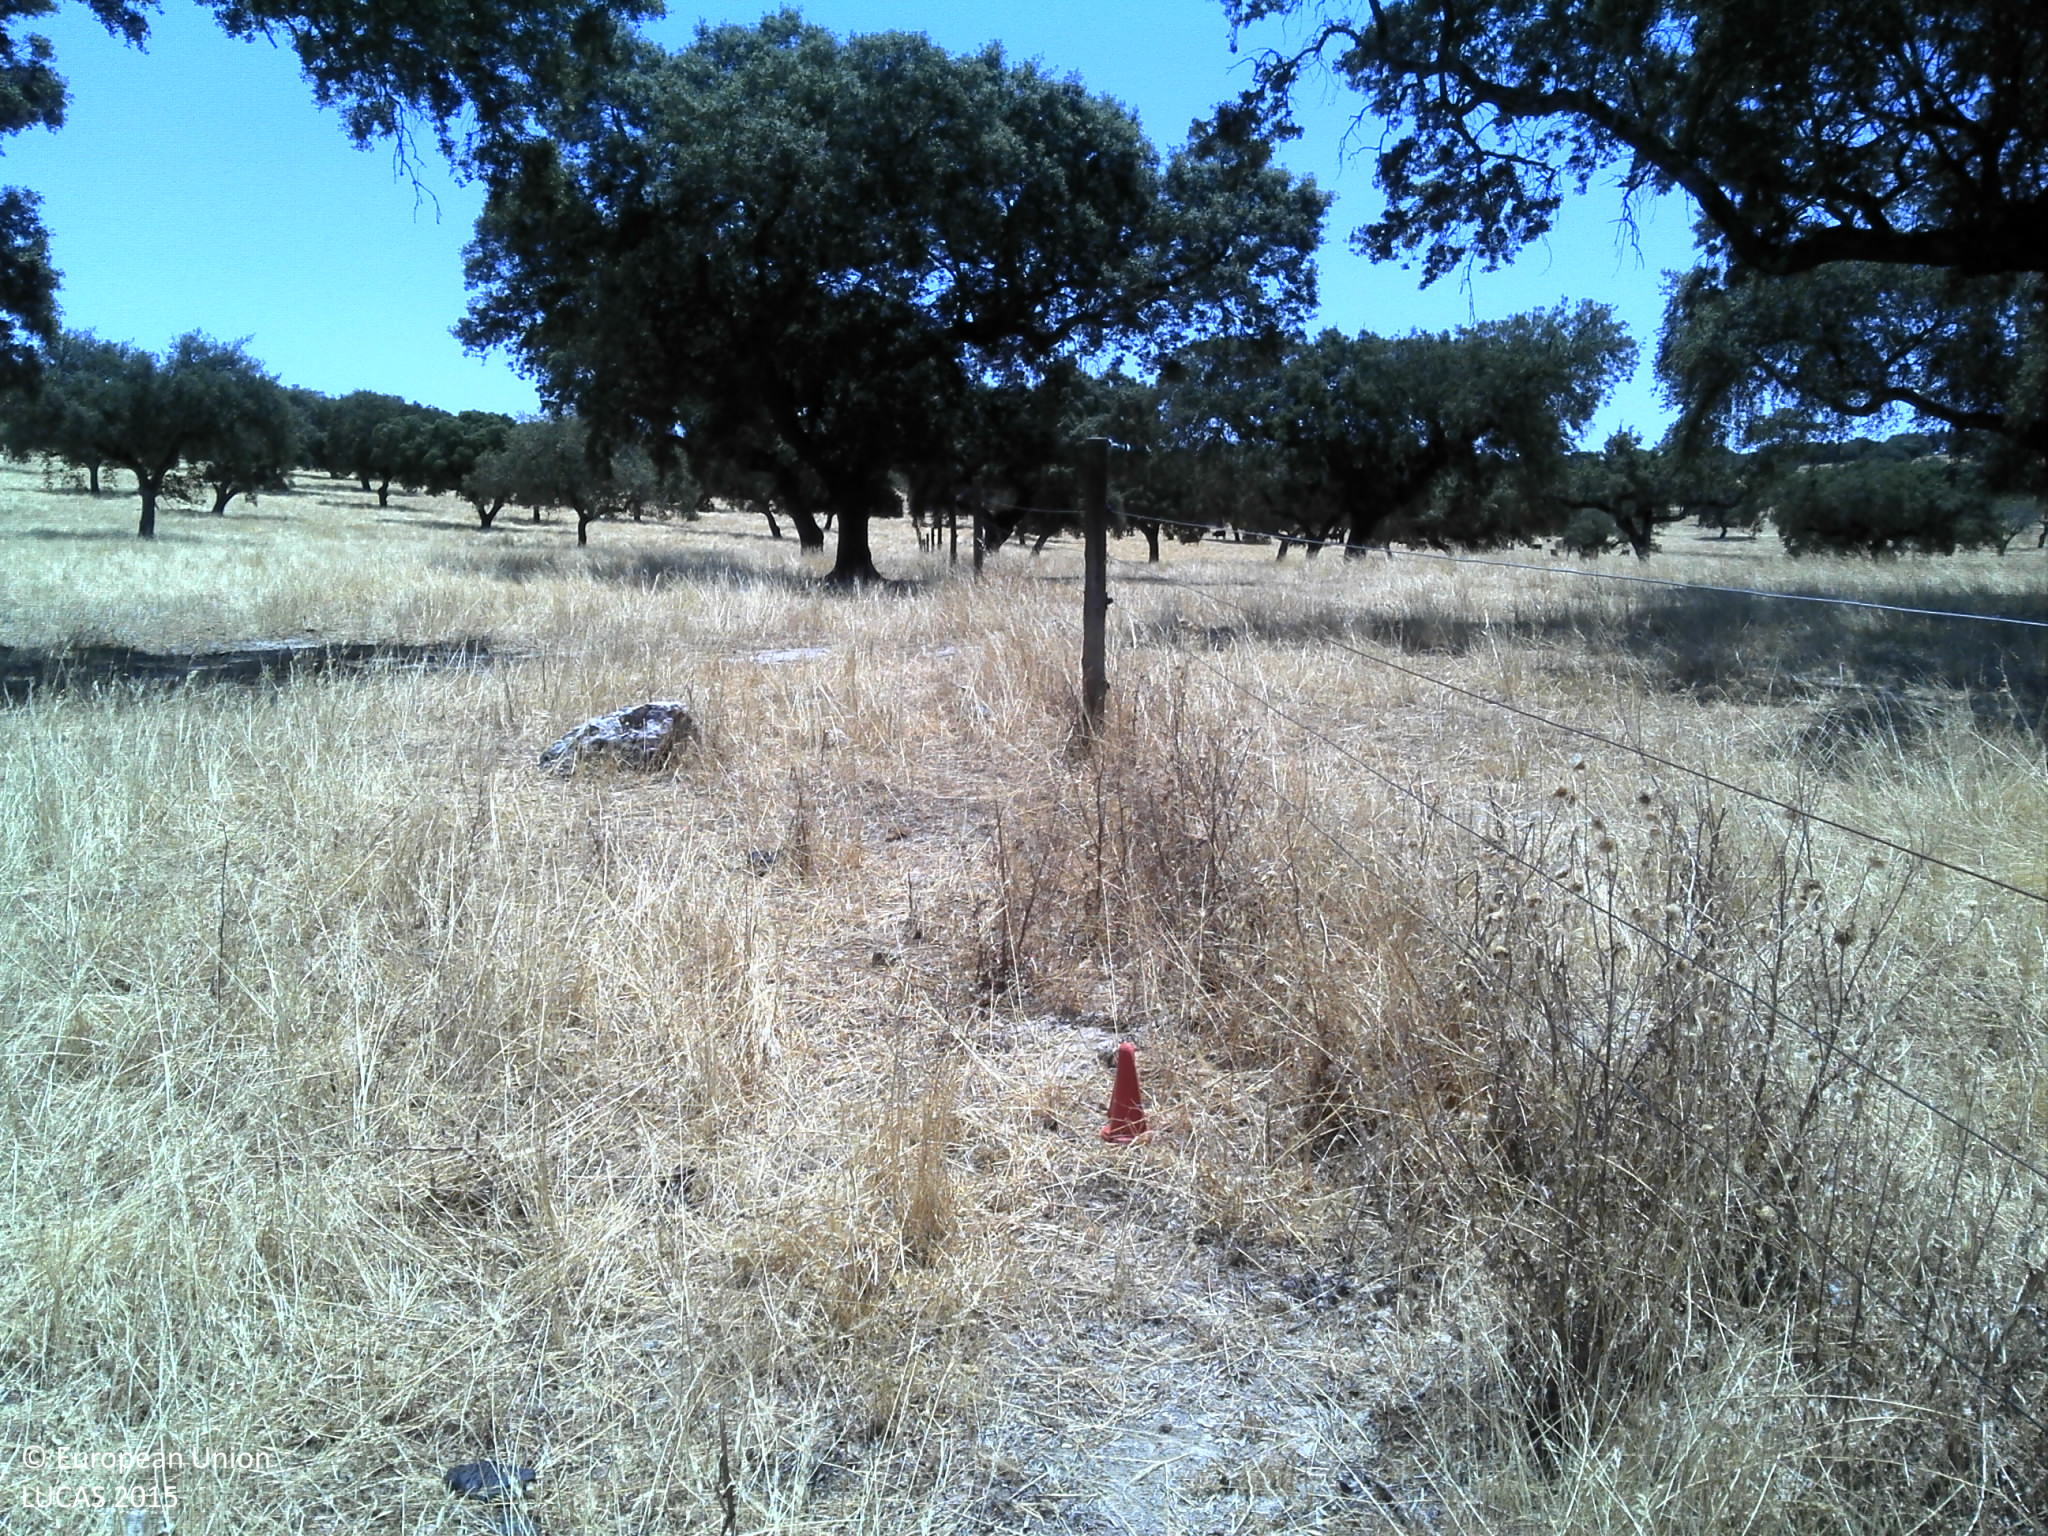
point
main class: Woodland
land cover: Broadleaved woodland
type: broadleaved evergreen forest
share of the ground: 10 - 25 %
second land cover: Grassland without tree/shrub cover
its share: 50 - 75 %
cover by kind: herbaceous plants 60 %, broadleaved forest trees 25 %, unconsolidated bare surface 15 %
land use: Forestry
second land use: Agriculture (excluding fallow land and kitchen gardens)
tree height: > 5 m
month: July
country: PT
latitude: 38.2390
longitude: -7.1889
